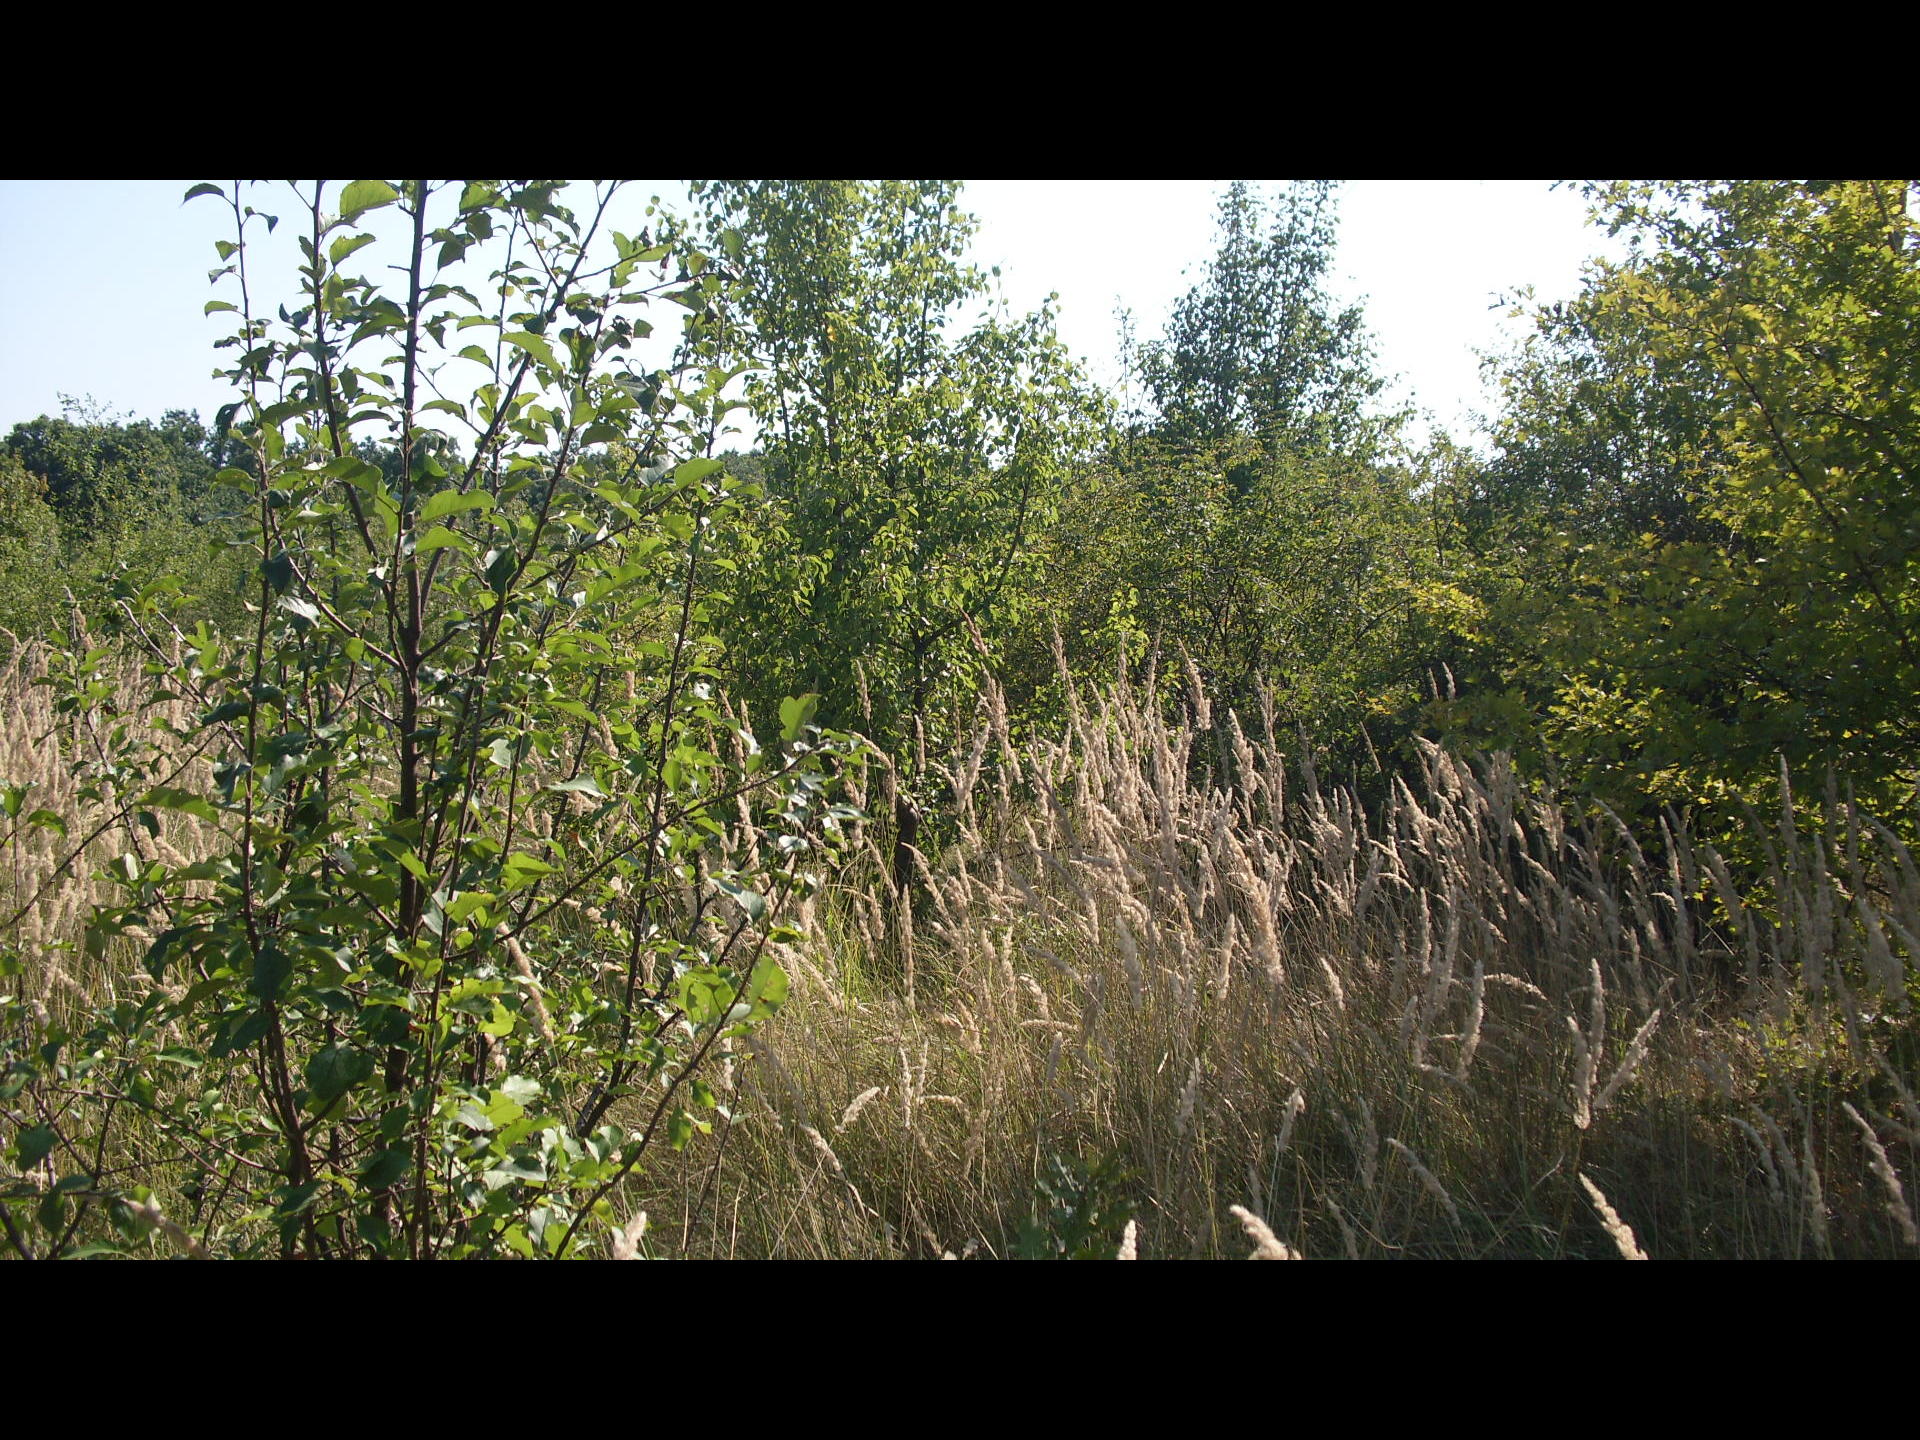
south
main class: Grassland
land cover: Grassland with sparse tree/shrub cover
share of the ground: > 75 %
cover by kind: herbaceous plants 90 %, broadleaved forest trees 5 %, shrubs 5 %
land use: Semi-natural and natural areas not in use
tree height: < 5 m
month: September
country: BG
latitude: 44.0026
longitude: 22.4175
